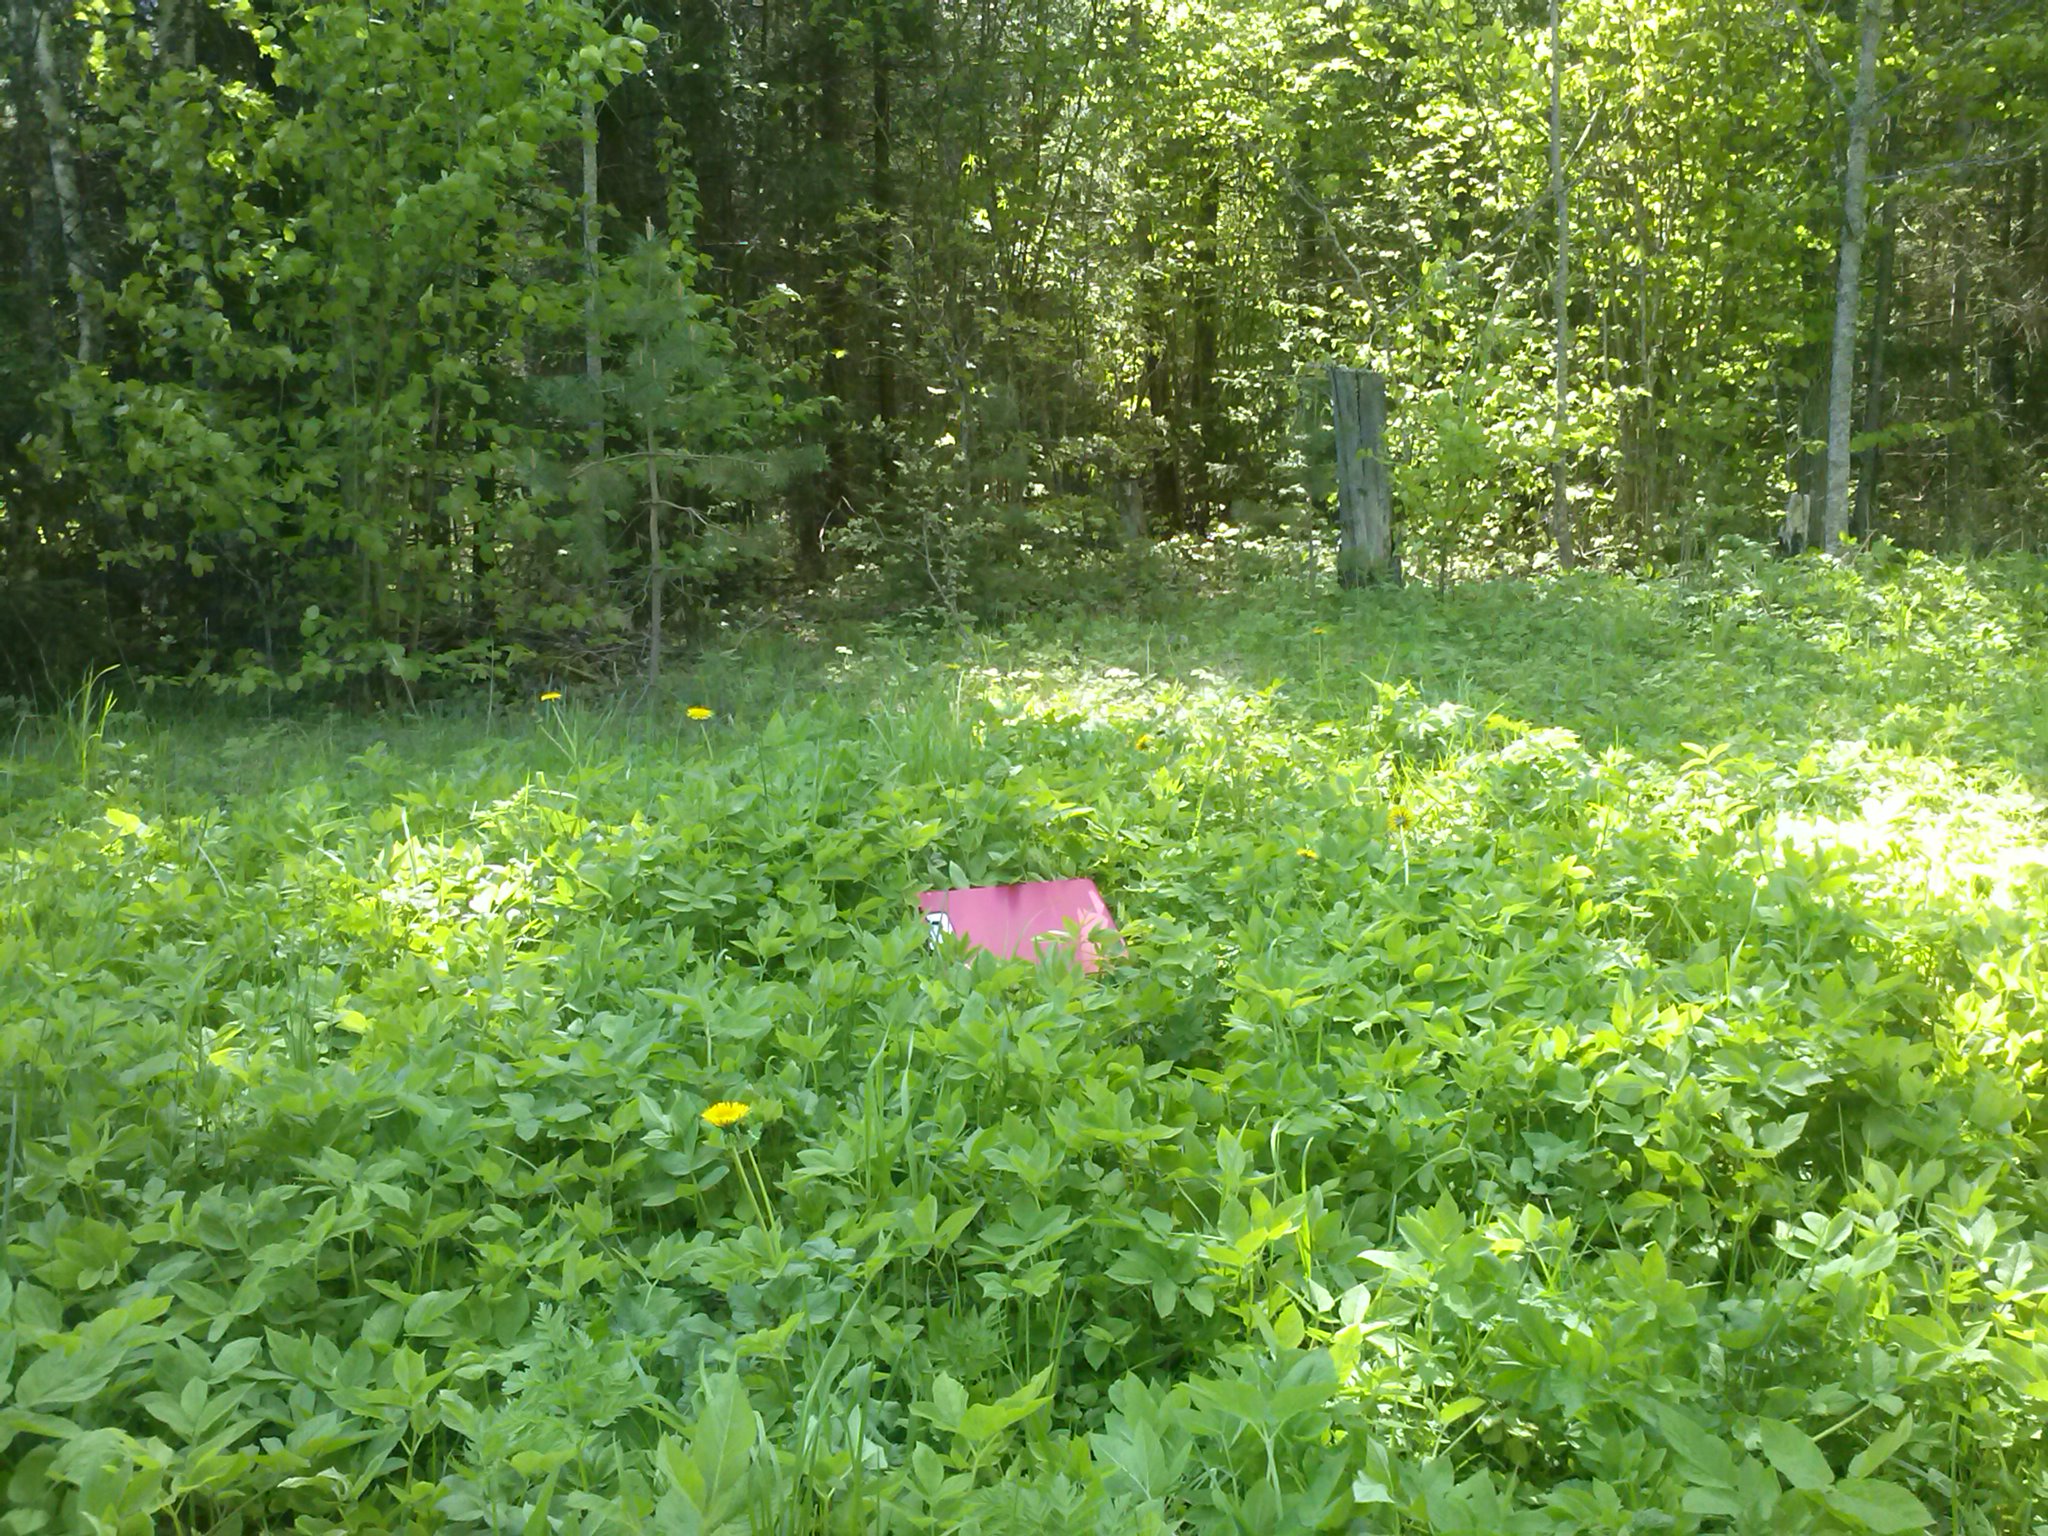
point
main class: Grassland
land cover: Grassland without tree/shrub cover
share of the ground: > 75 %
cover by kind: herbaceous plants 100 %
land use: Agriculture (excluding fallow land and kitchen gardens)
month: May
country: LV
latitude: 56.1882
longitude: 27.5026
